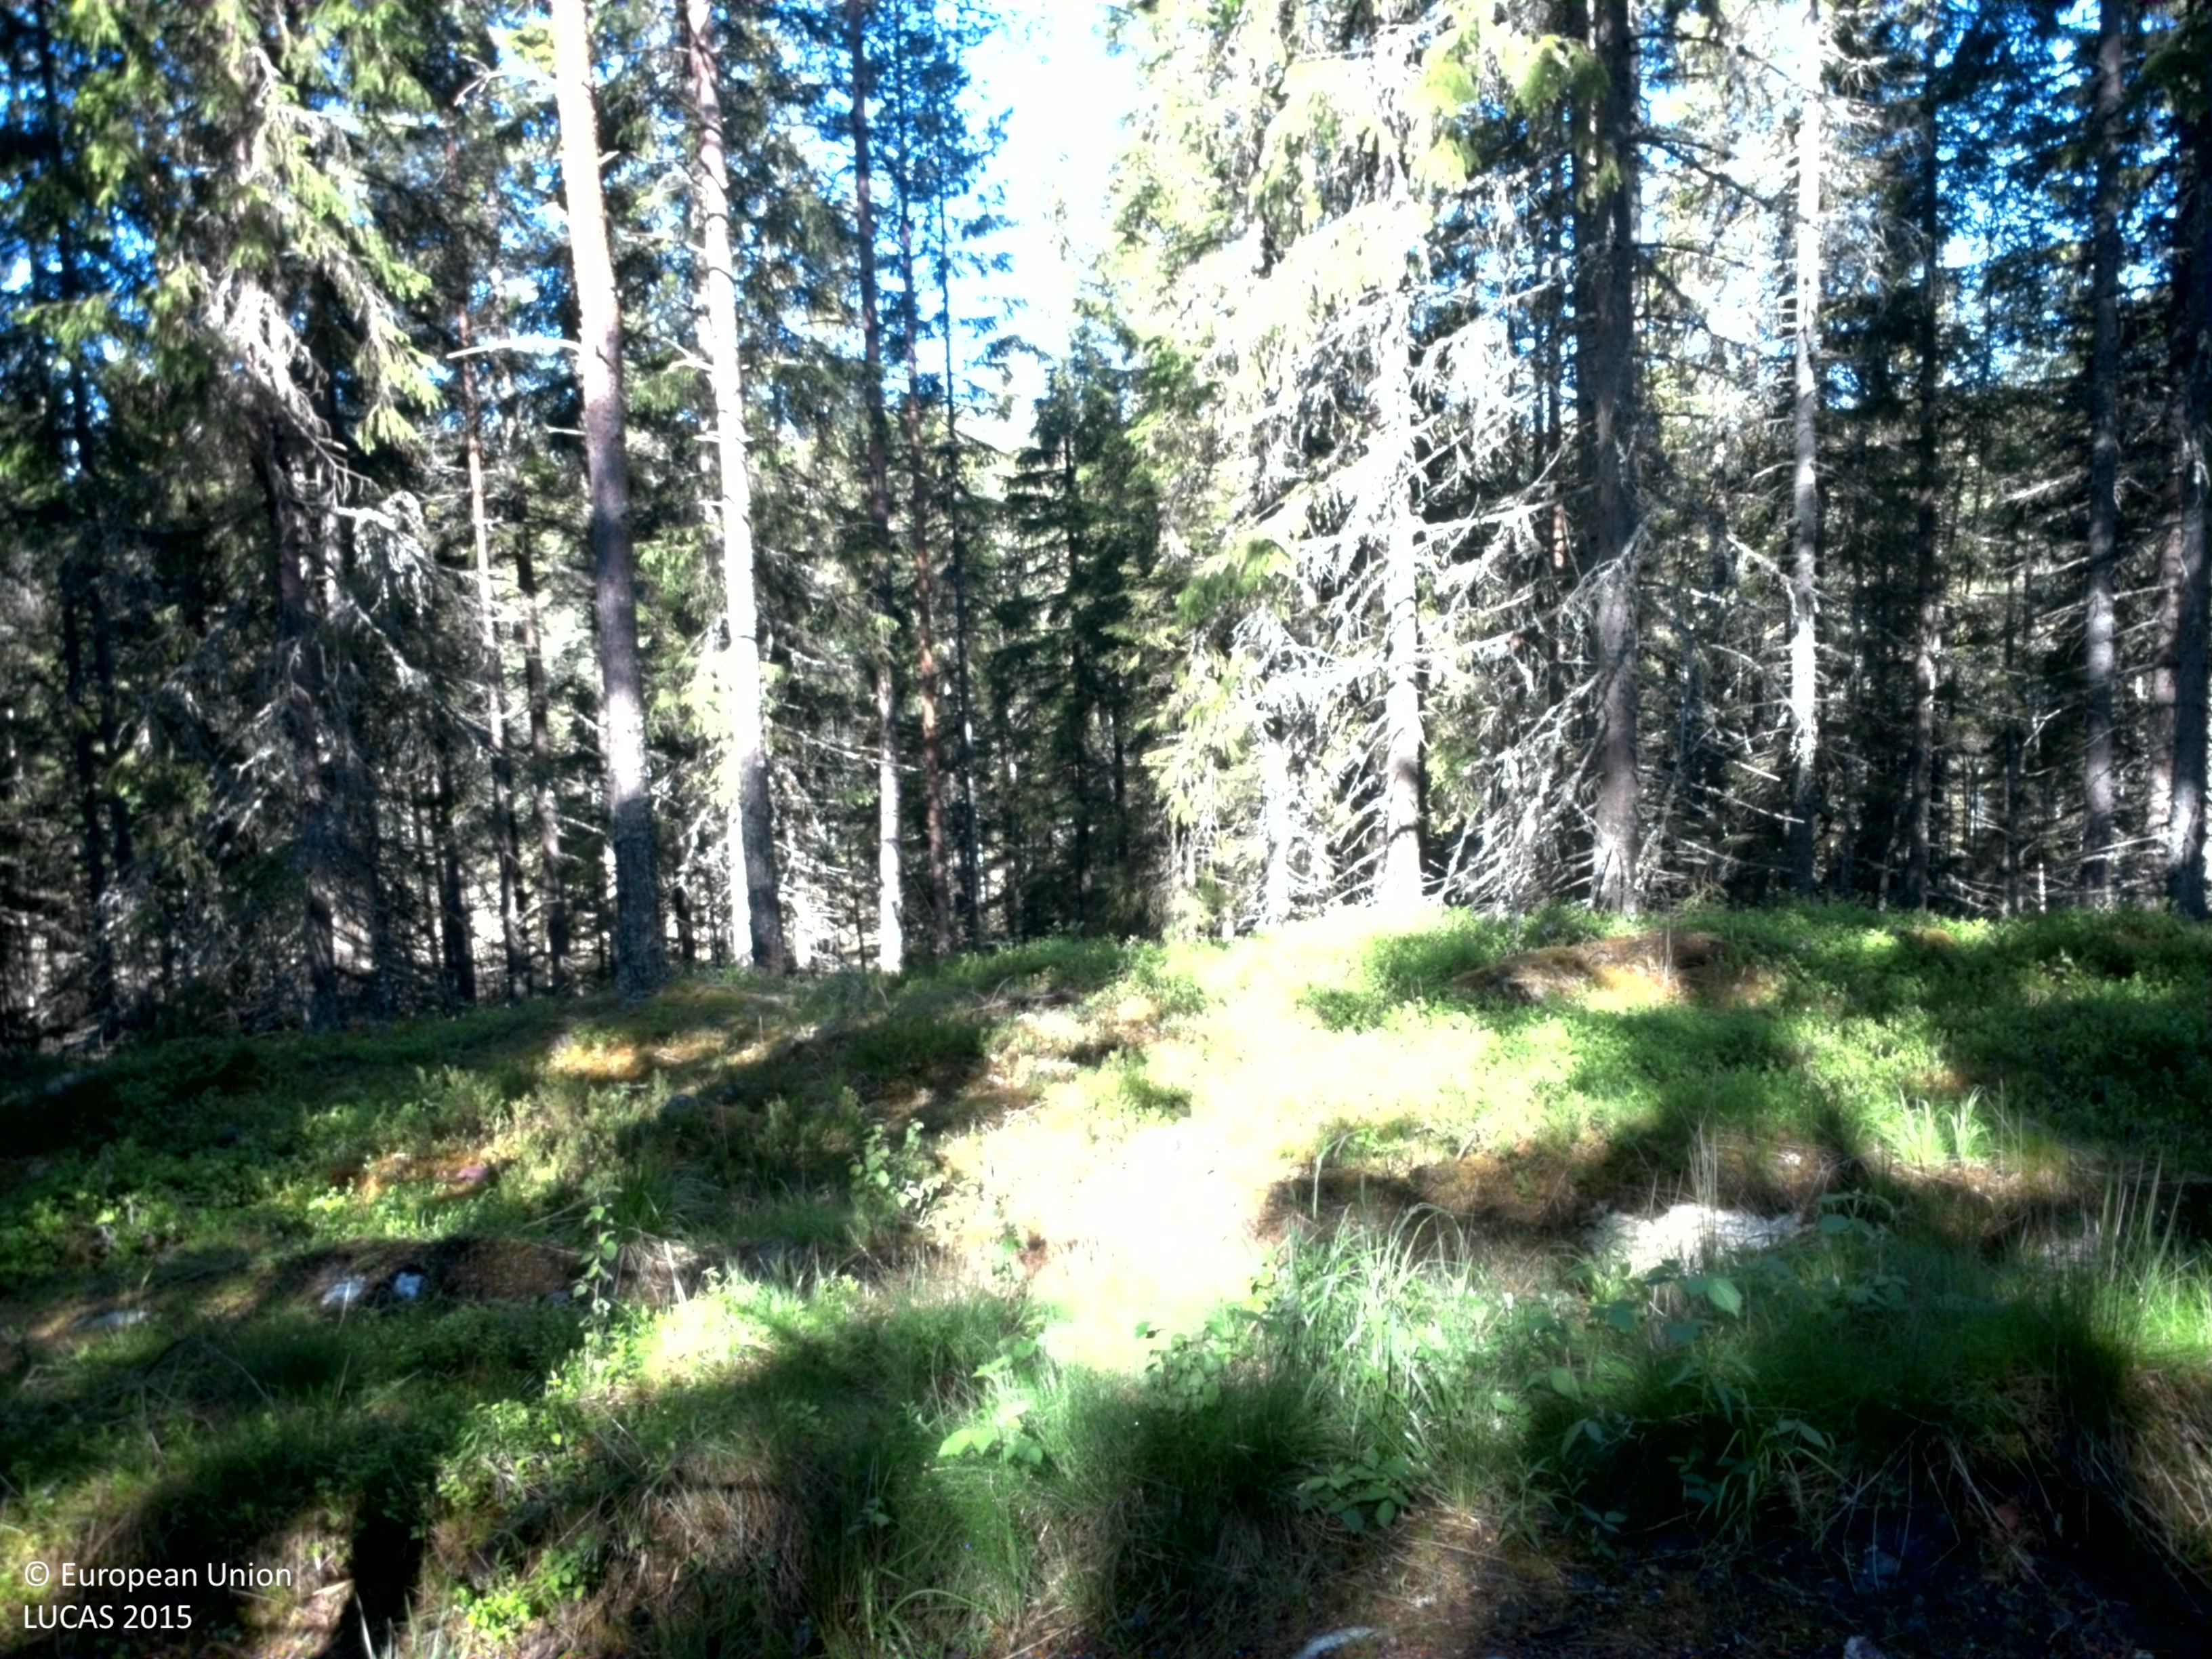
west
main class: Woodland
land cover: Spruce dominated coniferous woodland
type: boreal forest
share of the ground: > 75 %
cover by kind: coniferous forest trees 75 %, shrubs 10 %, lichens and mosses 10 %, broadleaved forest trees 5 %
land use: Forestry
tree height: > 5 m
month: June
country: SE
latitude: 59.4416
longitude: 12.3041
